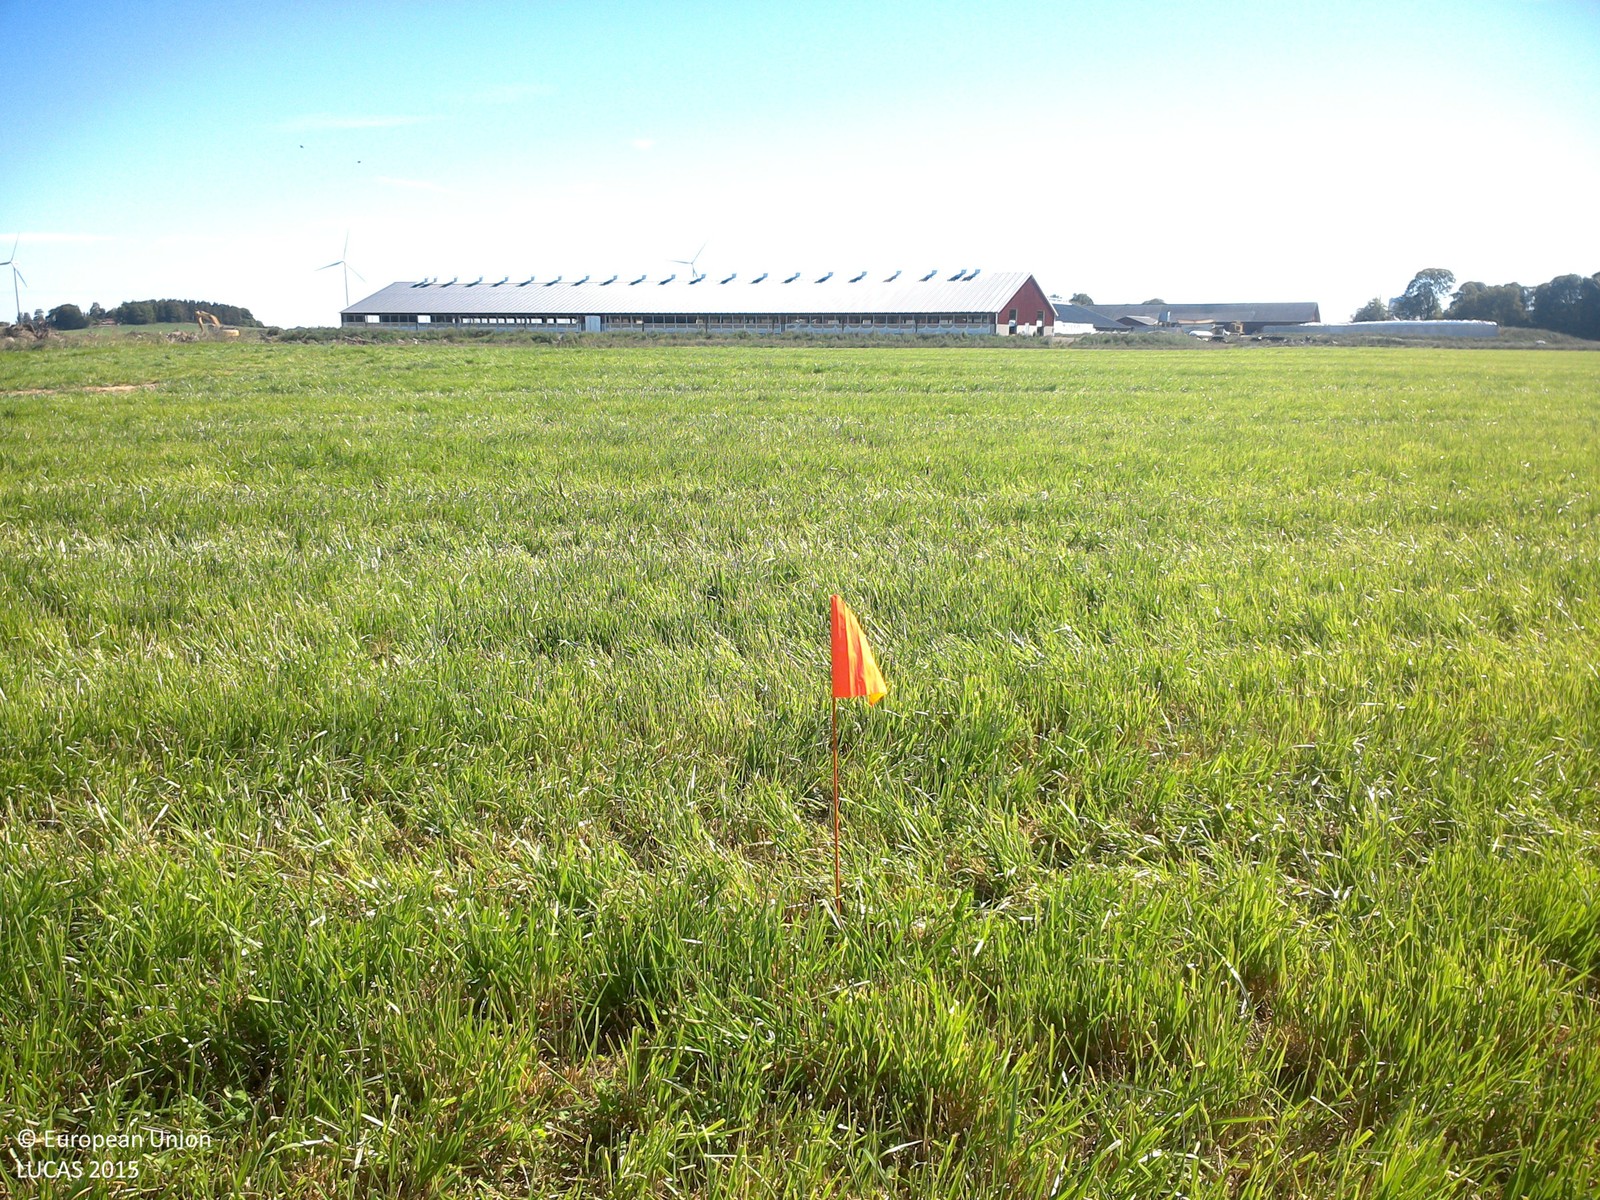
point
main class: Cropland
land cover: Temporary grasslands
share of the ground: > 75 %
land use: Agriculture (excluding fallow land and kitchen gardens)
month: July
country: SE
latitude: 58.4208
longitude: 15.3187
